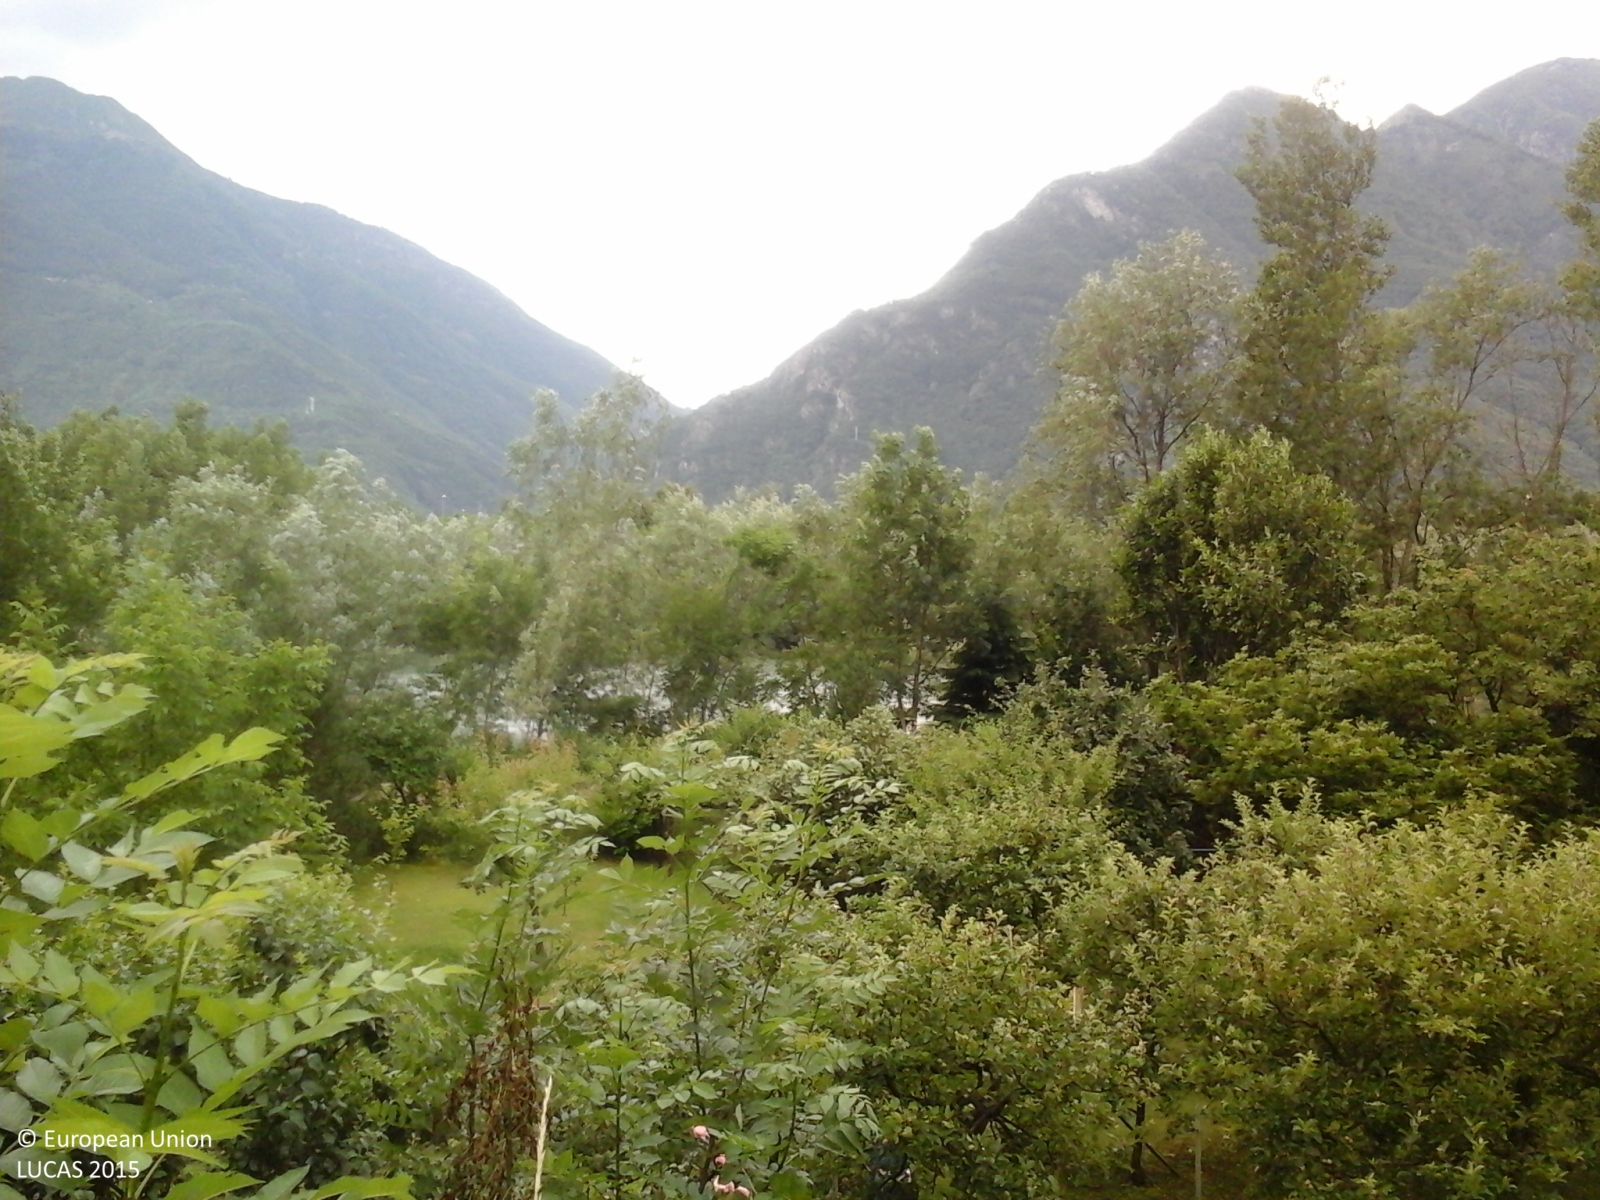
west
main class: Woodland
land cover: Broadleaved woodland
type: floodplain forest
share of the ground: > 75 %
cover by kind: broadleaved forest trees 100 %
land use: Semi-natural and natural areas not in use
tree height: > 5 m
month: June
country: IT
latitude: 46.0311
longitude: 8.2841
